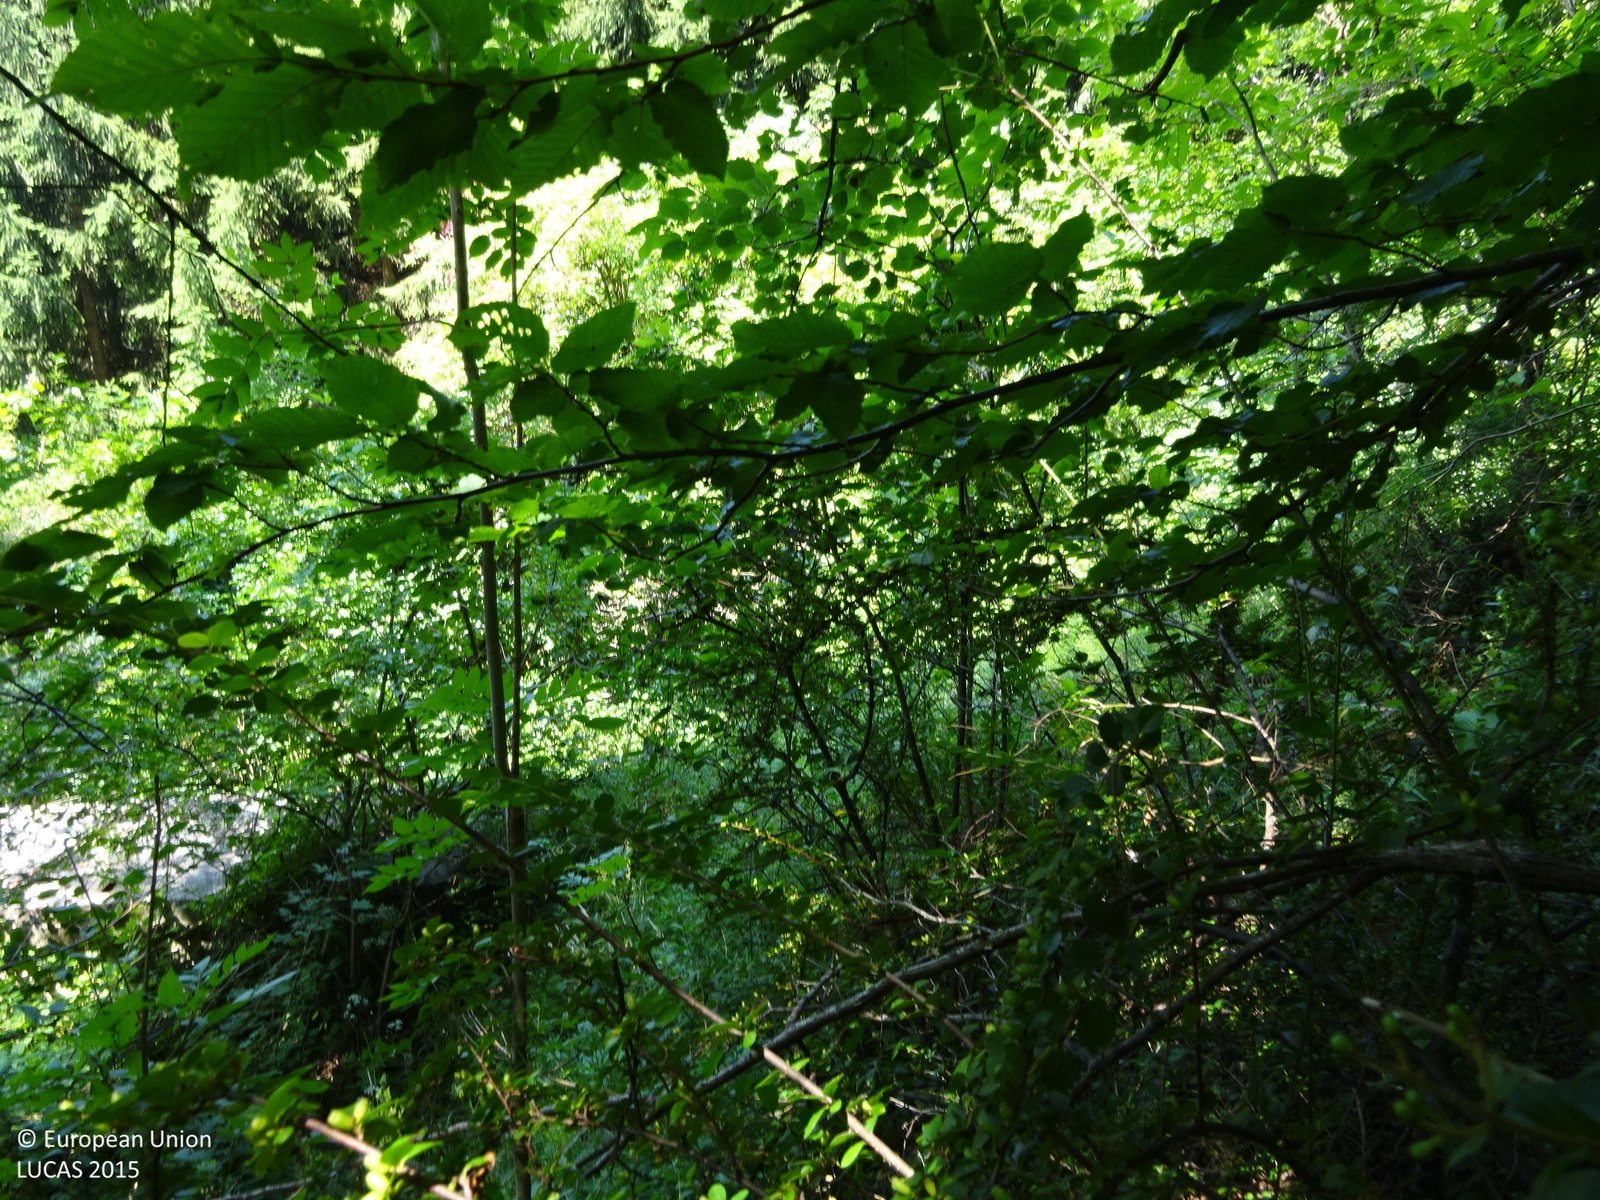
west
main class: Woodland
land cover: Broadleaved woodland
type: hemiboreal forest and nemoral coniferous forest and mixed broadleaved-coniferous forest
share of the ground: > 75 %
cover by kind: broadleaved forest trees 90 %, shrubs 10 %
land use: Forestry
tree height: > 5 m
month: July
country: AT
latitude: 47.2100
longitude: 15.3471
